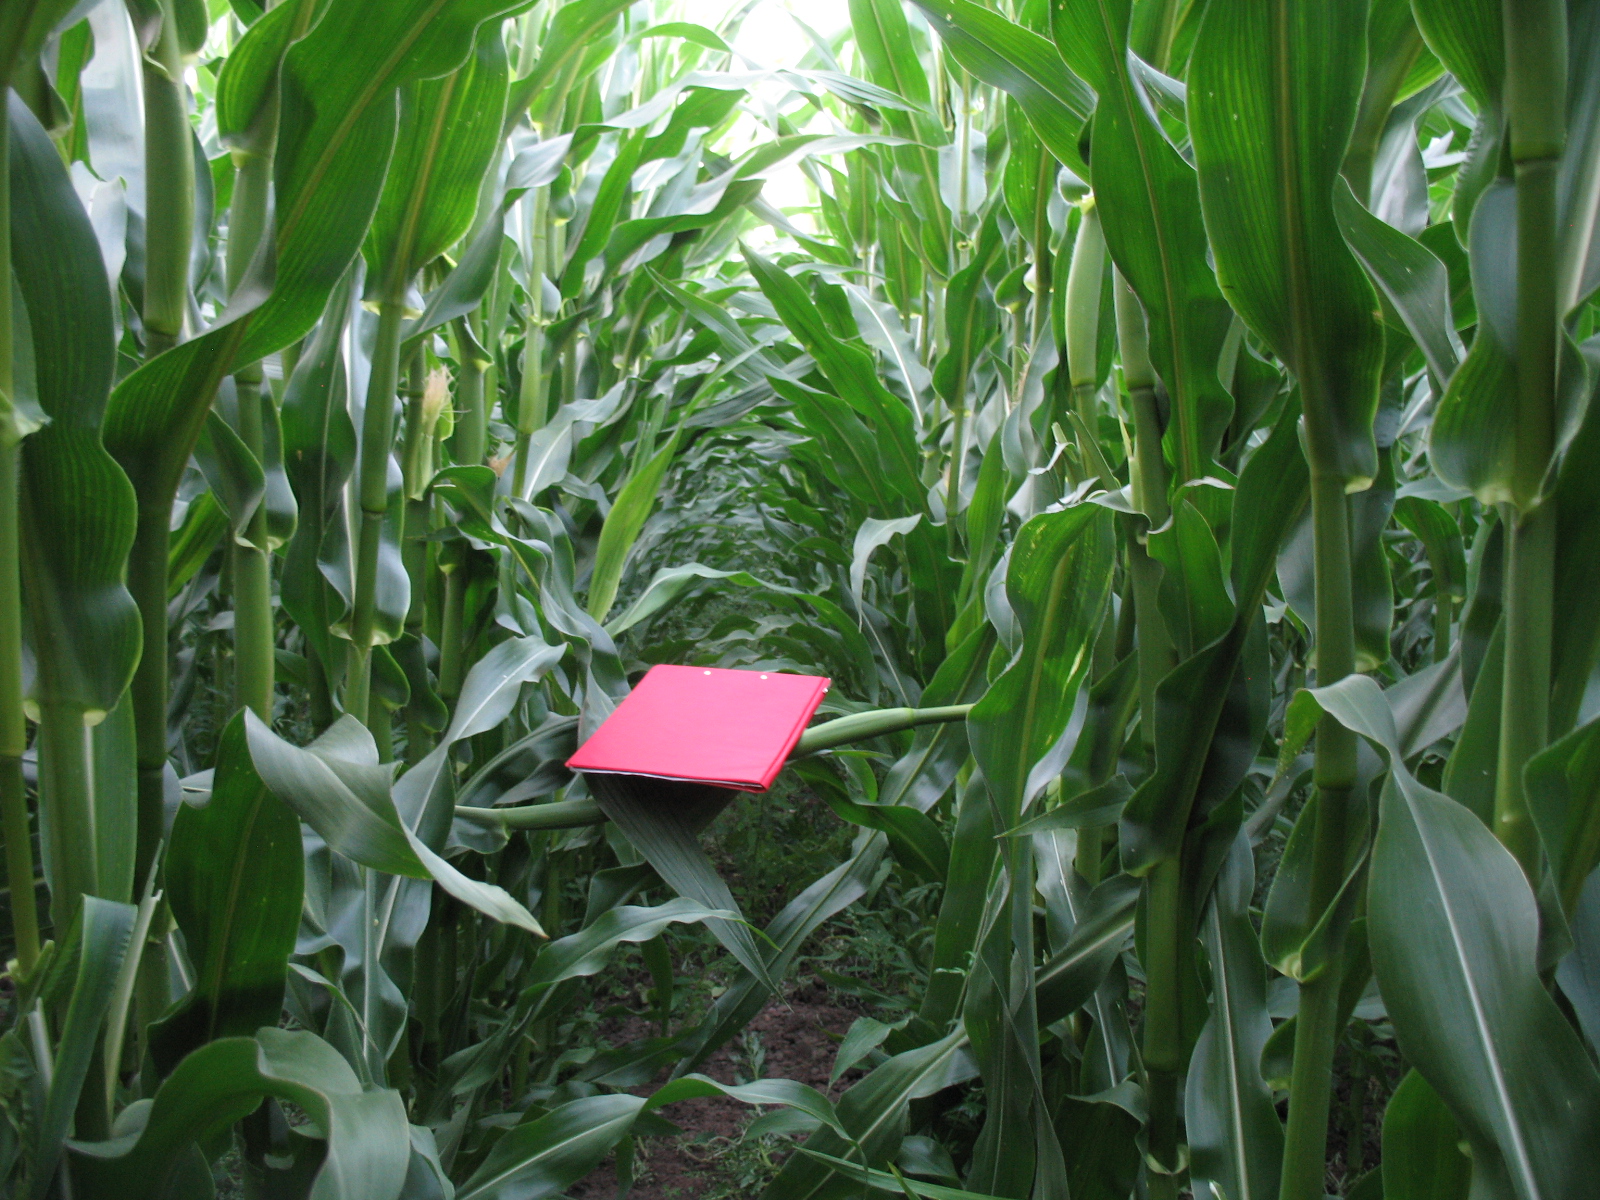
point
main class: Cropland
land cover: Maize
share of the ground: > 75 %
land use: Agriculture (excluding fallow land and kitchen gardens)
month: August
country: LV
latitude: 56.3594
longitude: 25.4803
